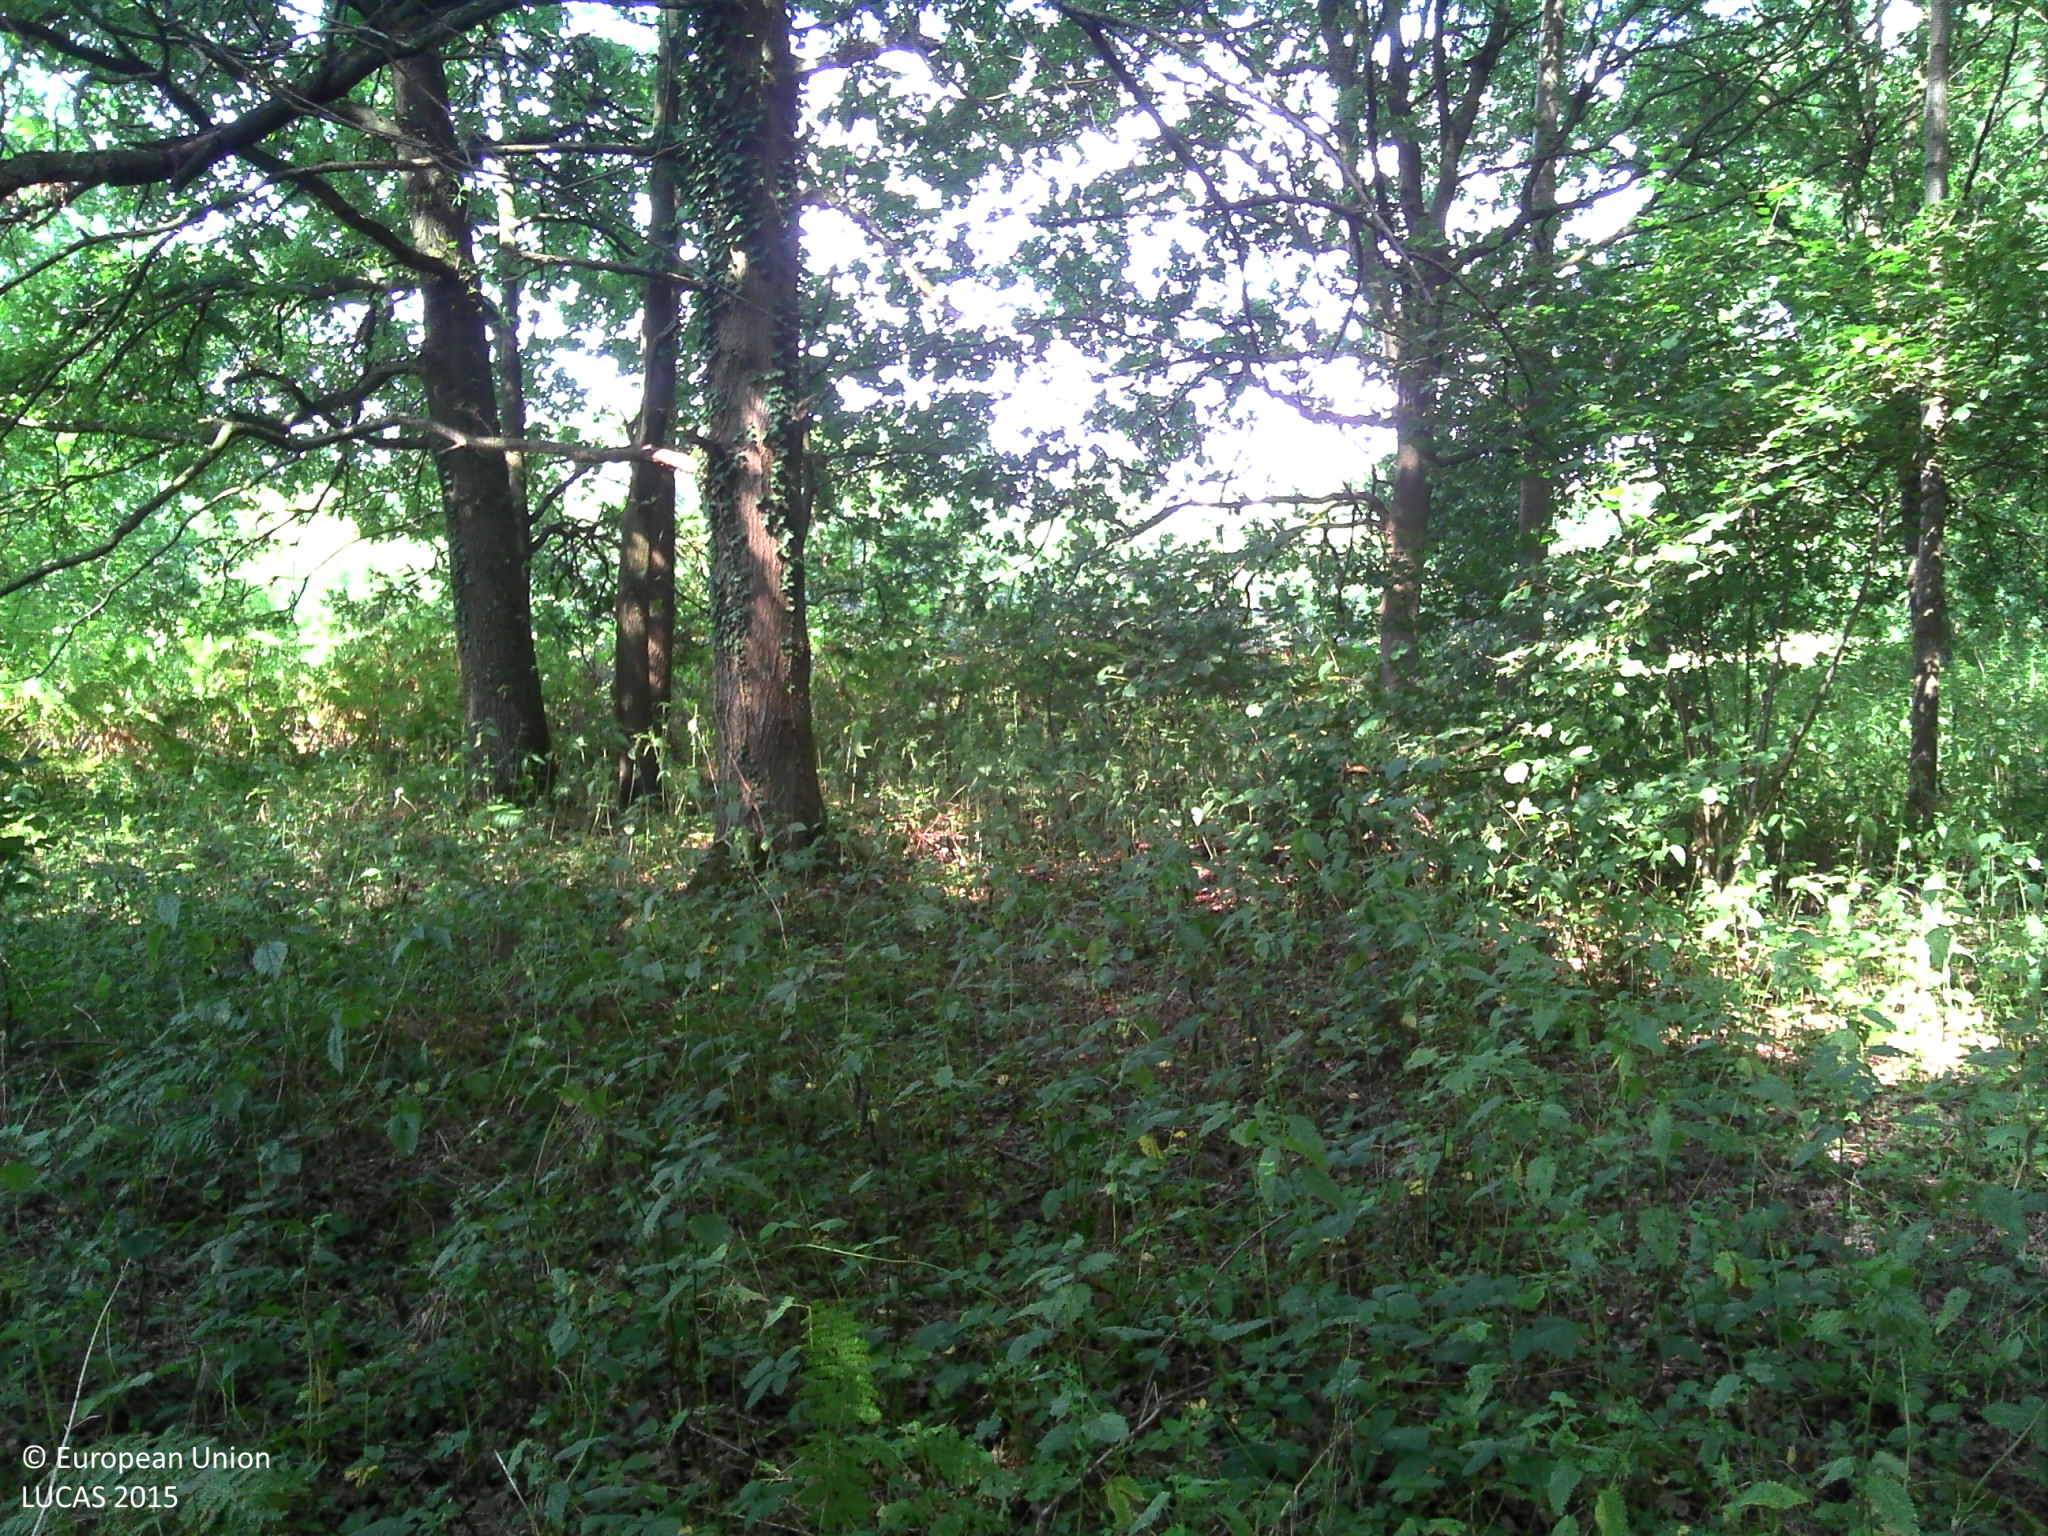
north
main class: Woodland
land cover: Broadleaved woodland
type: floodplain forest
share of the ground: > 75 %
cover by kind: broadleaved forest trees 90 %, herbaceous plants 10 %
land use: Forestry
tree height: > 5 m
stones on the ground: < 10 %
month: August
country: BE
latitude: 51.1427
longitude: 5.1232
